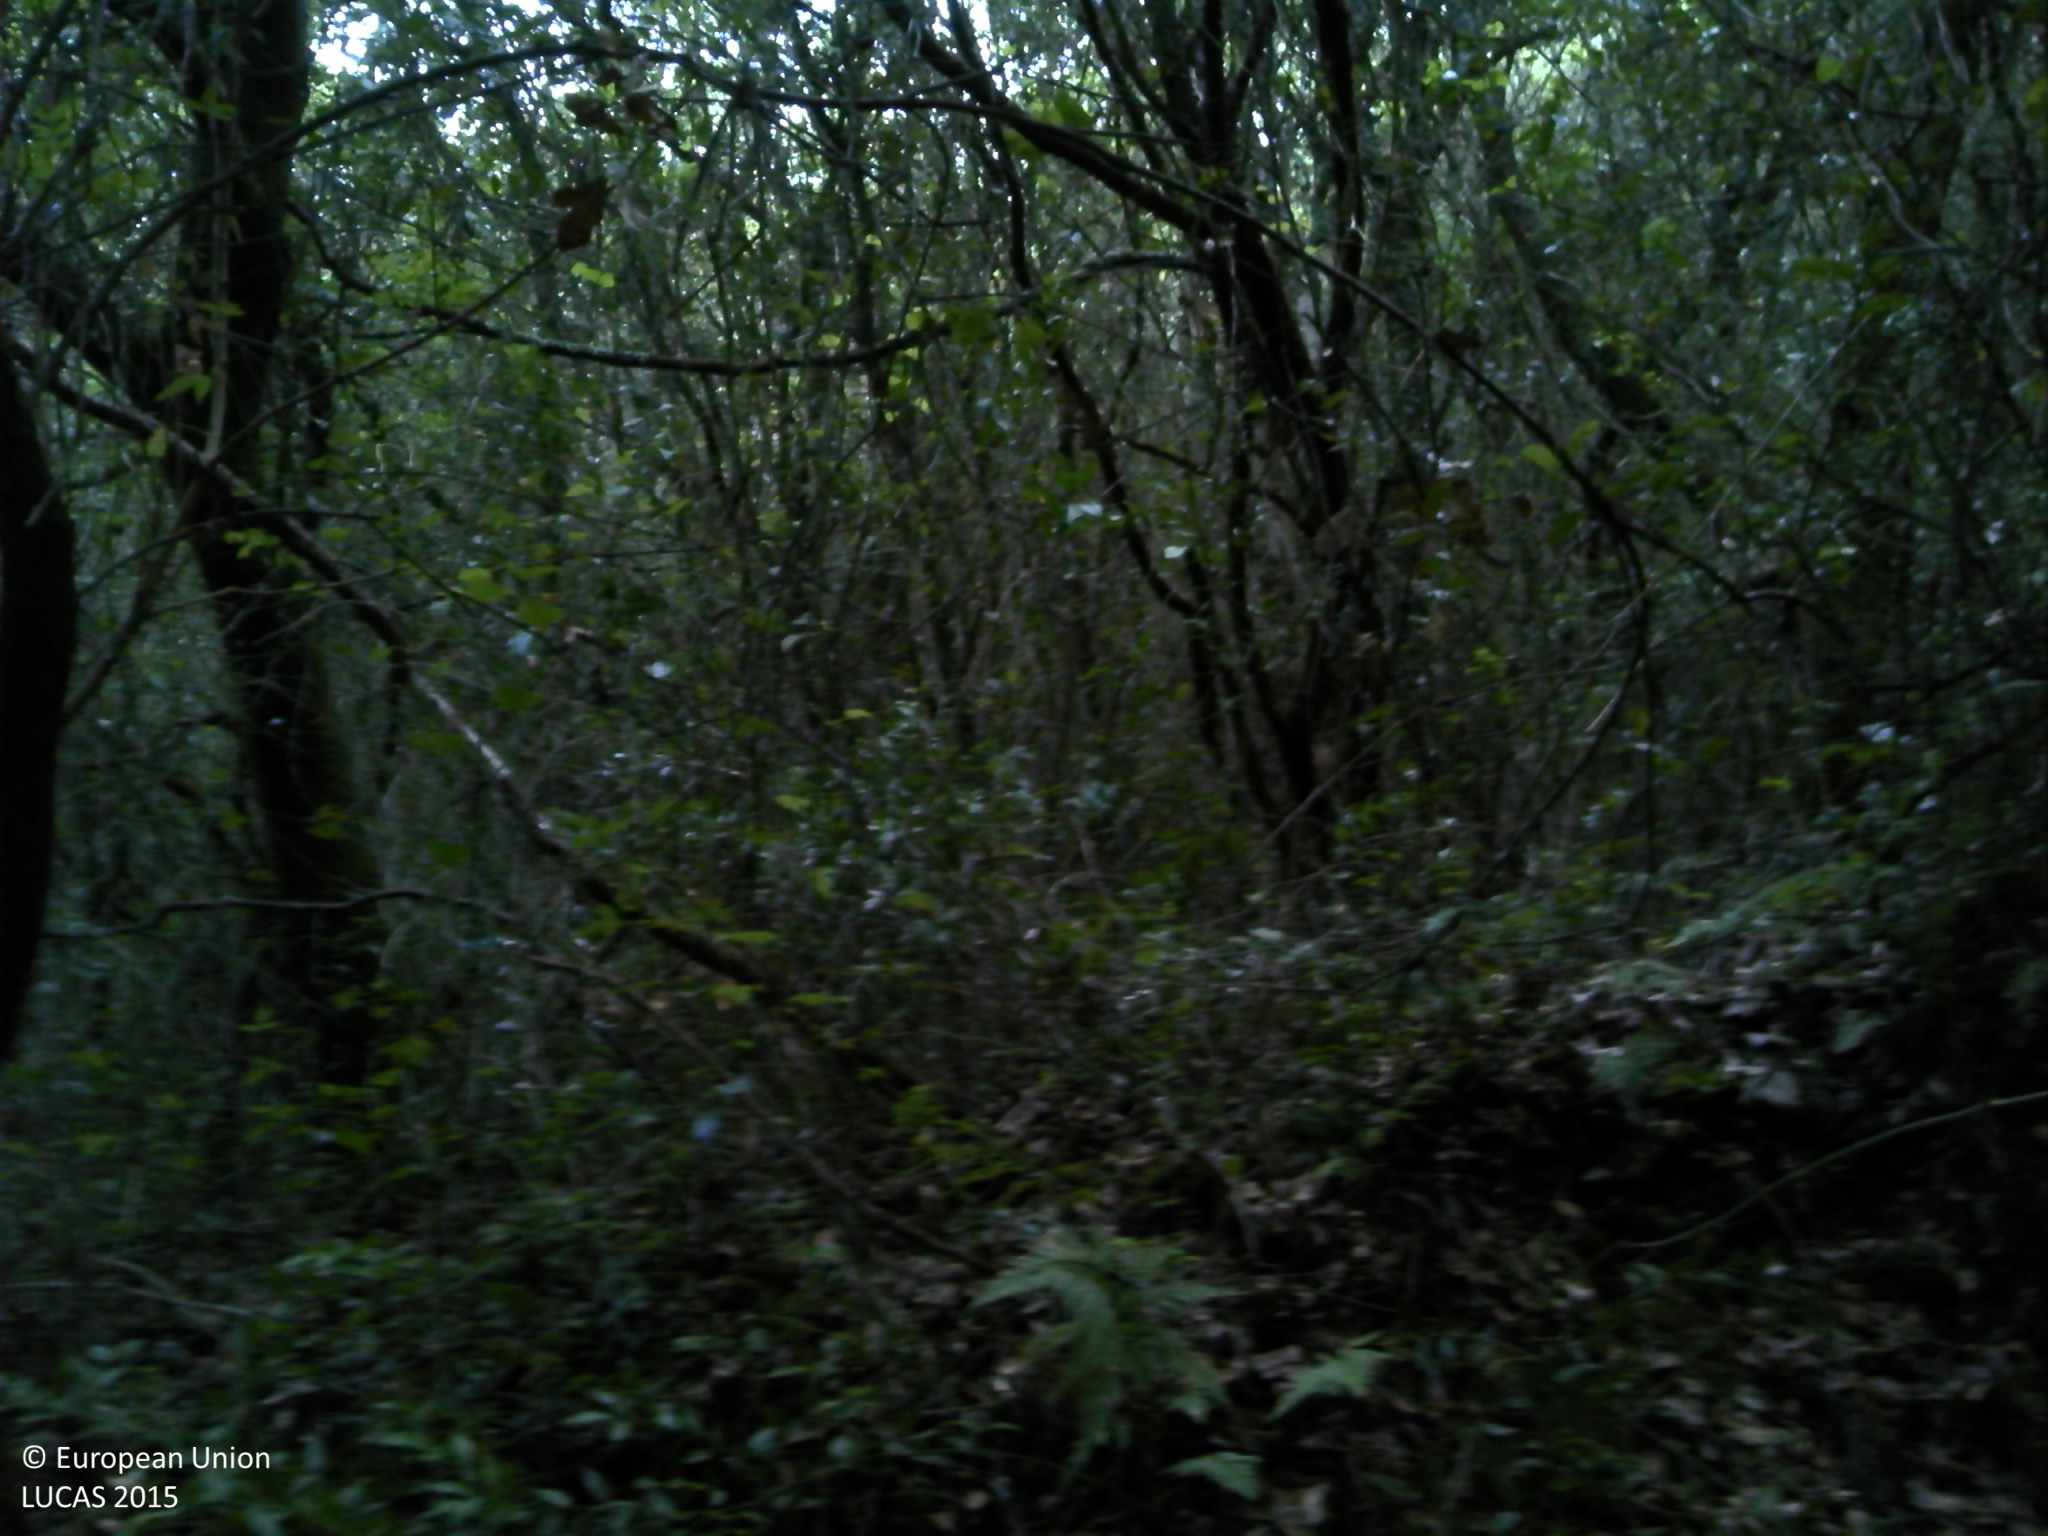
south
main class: Woodland
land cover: Broadleaved woodland
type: thermophilous deciduous forest
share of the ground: > 75 %
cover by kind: broadleaved forest trees 75 %, shrubs 25 %
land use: Semi-natural and natural areas not in use
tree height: < 5 m
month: June
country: PT
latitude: 39.0838
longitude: -9.2411
